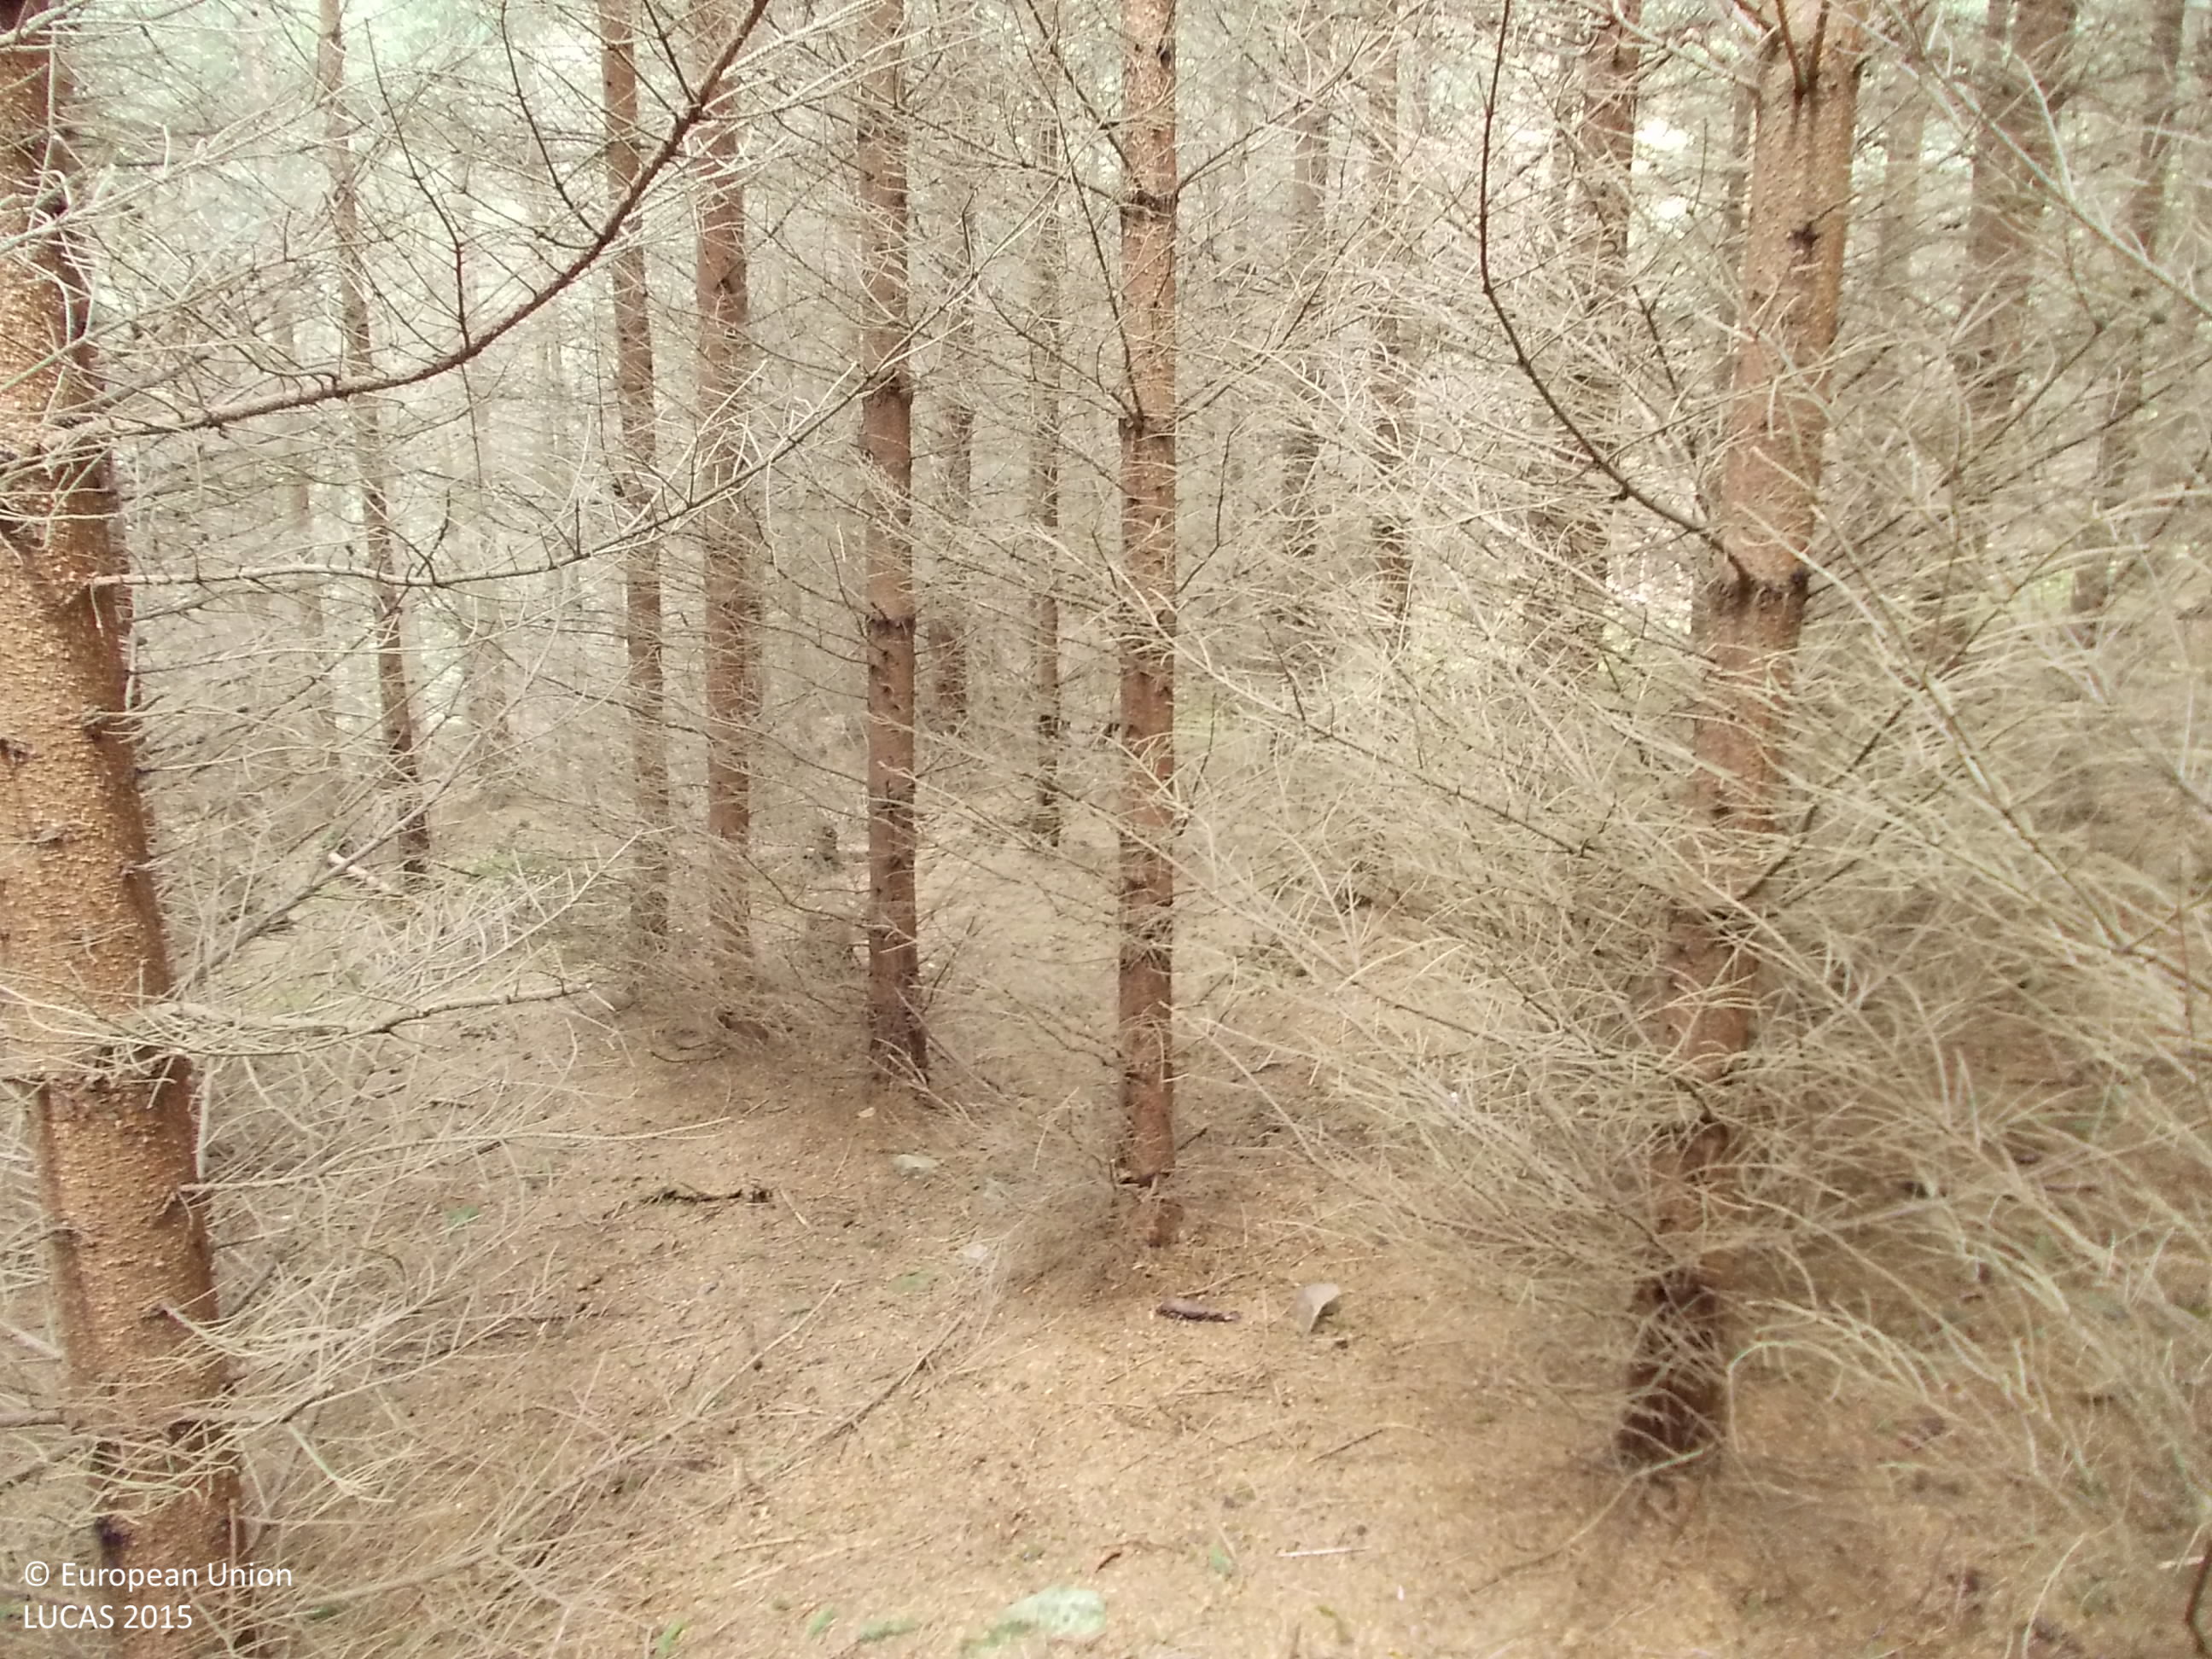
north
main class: Woodland
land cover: Spruce dominated coniferous woodland
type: hemiboreal forest and nemoral coniferous forest and mixed broadleaved-coniferous forest
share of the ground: > 75 %
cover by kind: coniferous forest trees 100 %
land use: Forestry
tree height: > 5 m
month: May
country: CZ
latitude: 49.2395
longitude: 13.7774
